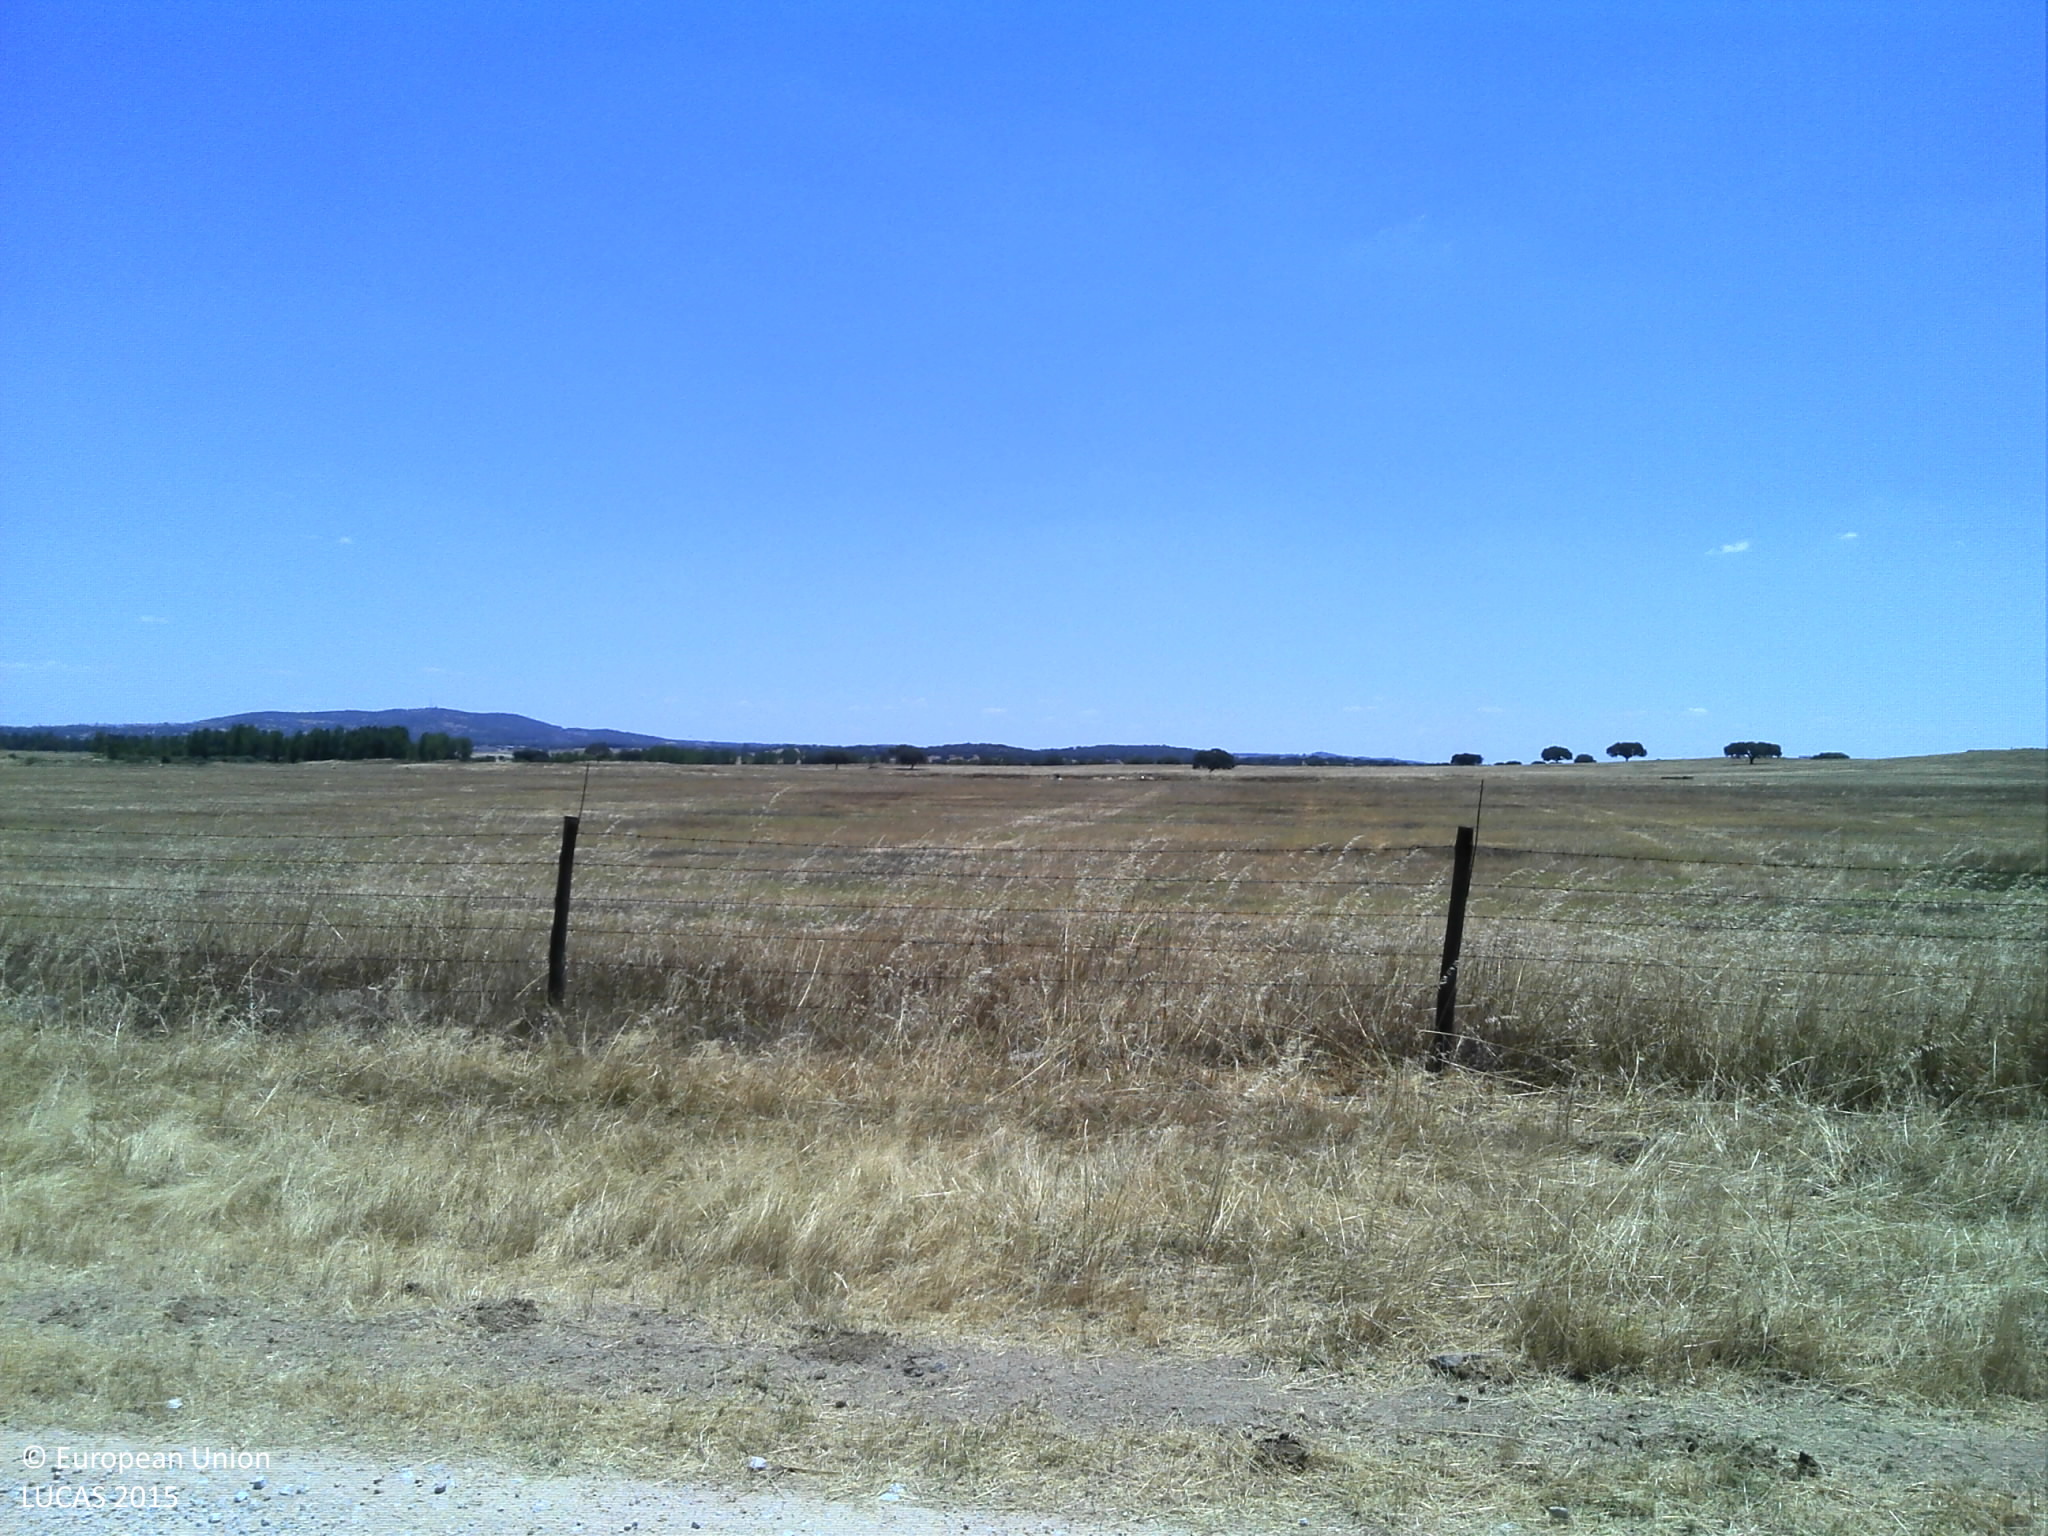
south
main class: Grassland
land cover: Grassland without tree/shrub cover
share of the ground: 10 - 25 %
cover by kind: unconsolidated bare surface 90 %, herbaceous plants 10 %
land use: Agriculture (excluding fallow land and kitchen gardens)
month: June
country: PT
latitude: 38.3665
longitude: -8.0892
